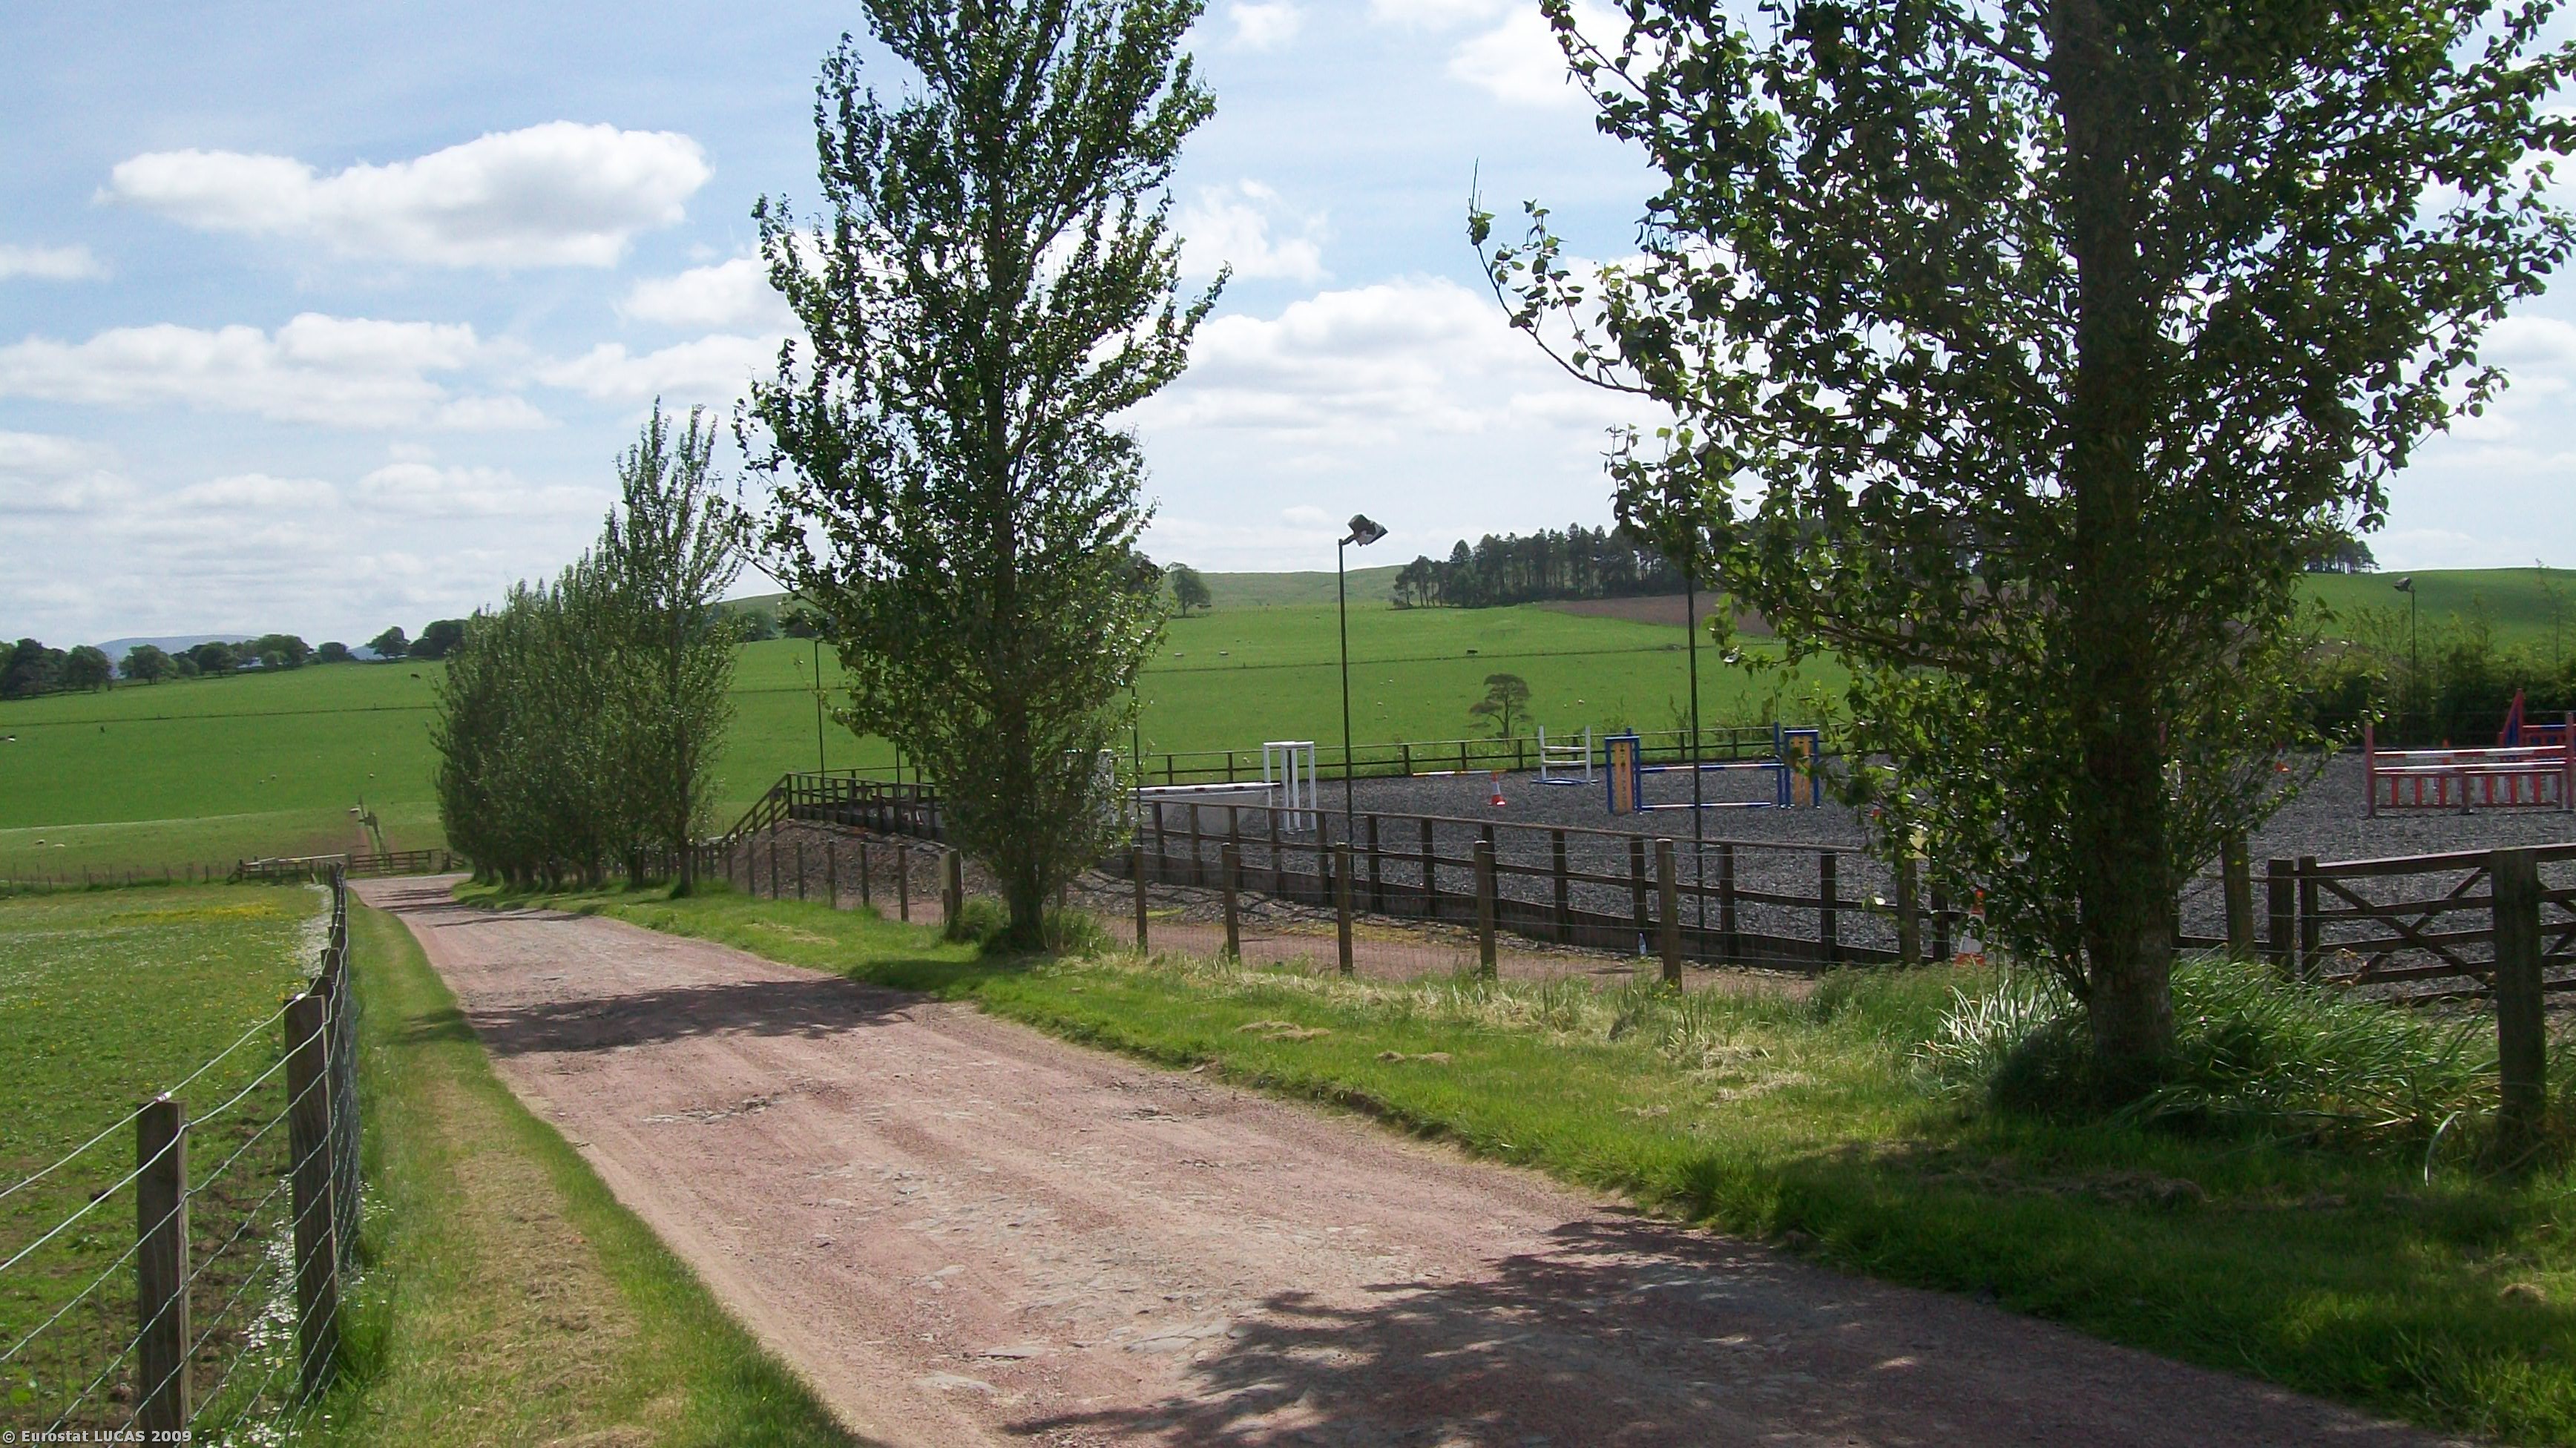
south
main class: Artificial land
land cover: Non built-up area features
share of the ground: > 75 %
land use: Residential
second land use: Agriculture (excluding fallow land and kitchen gardens)
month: June
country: GB
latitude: 55.6693
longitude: -3.5134
